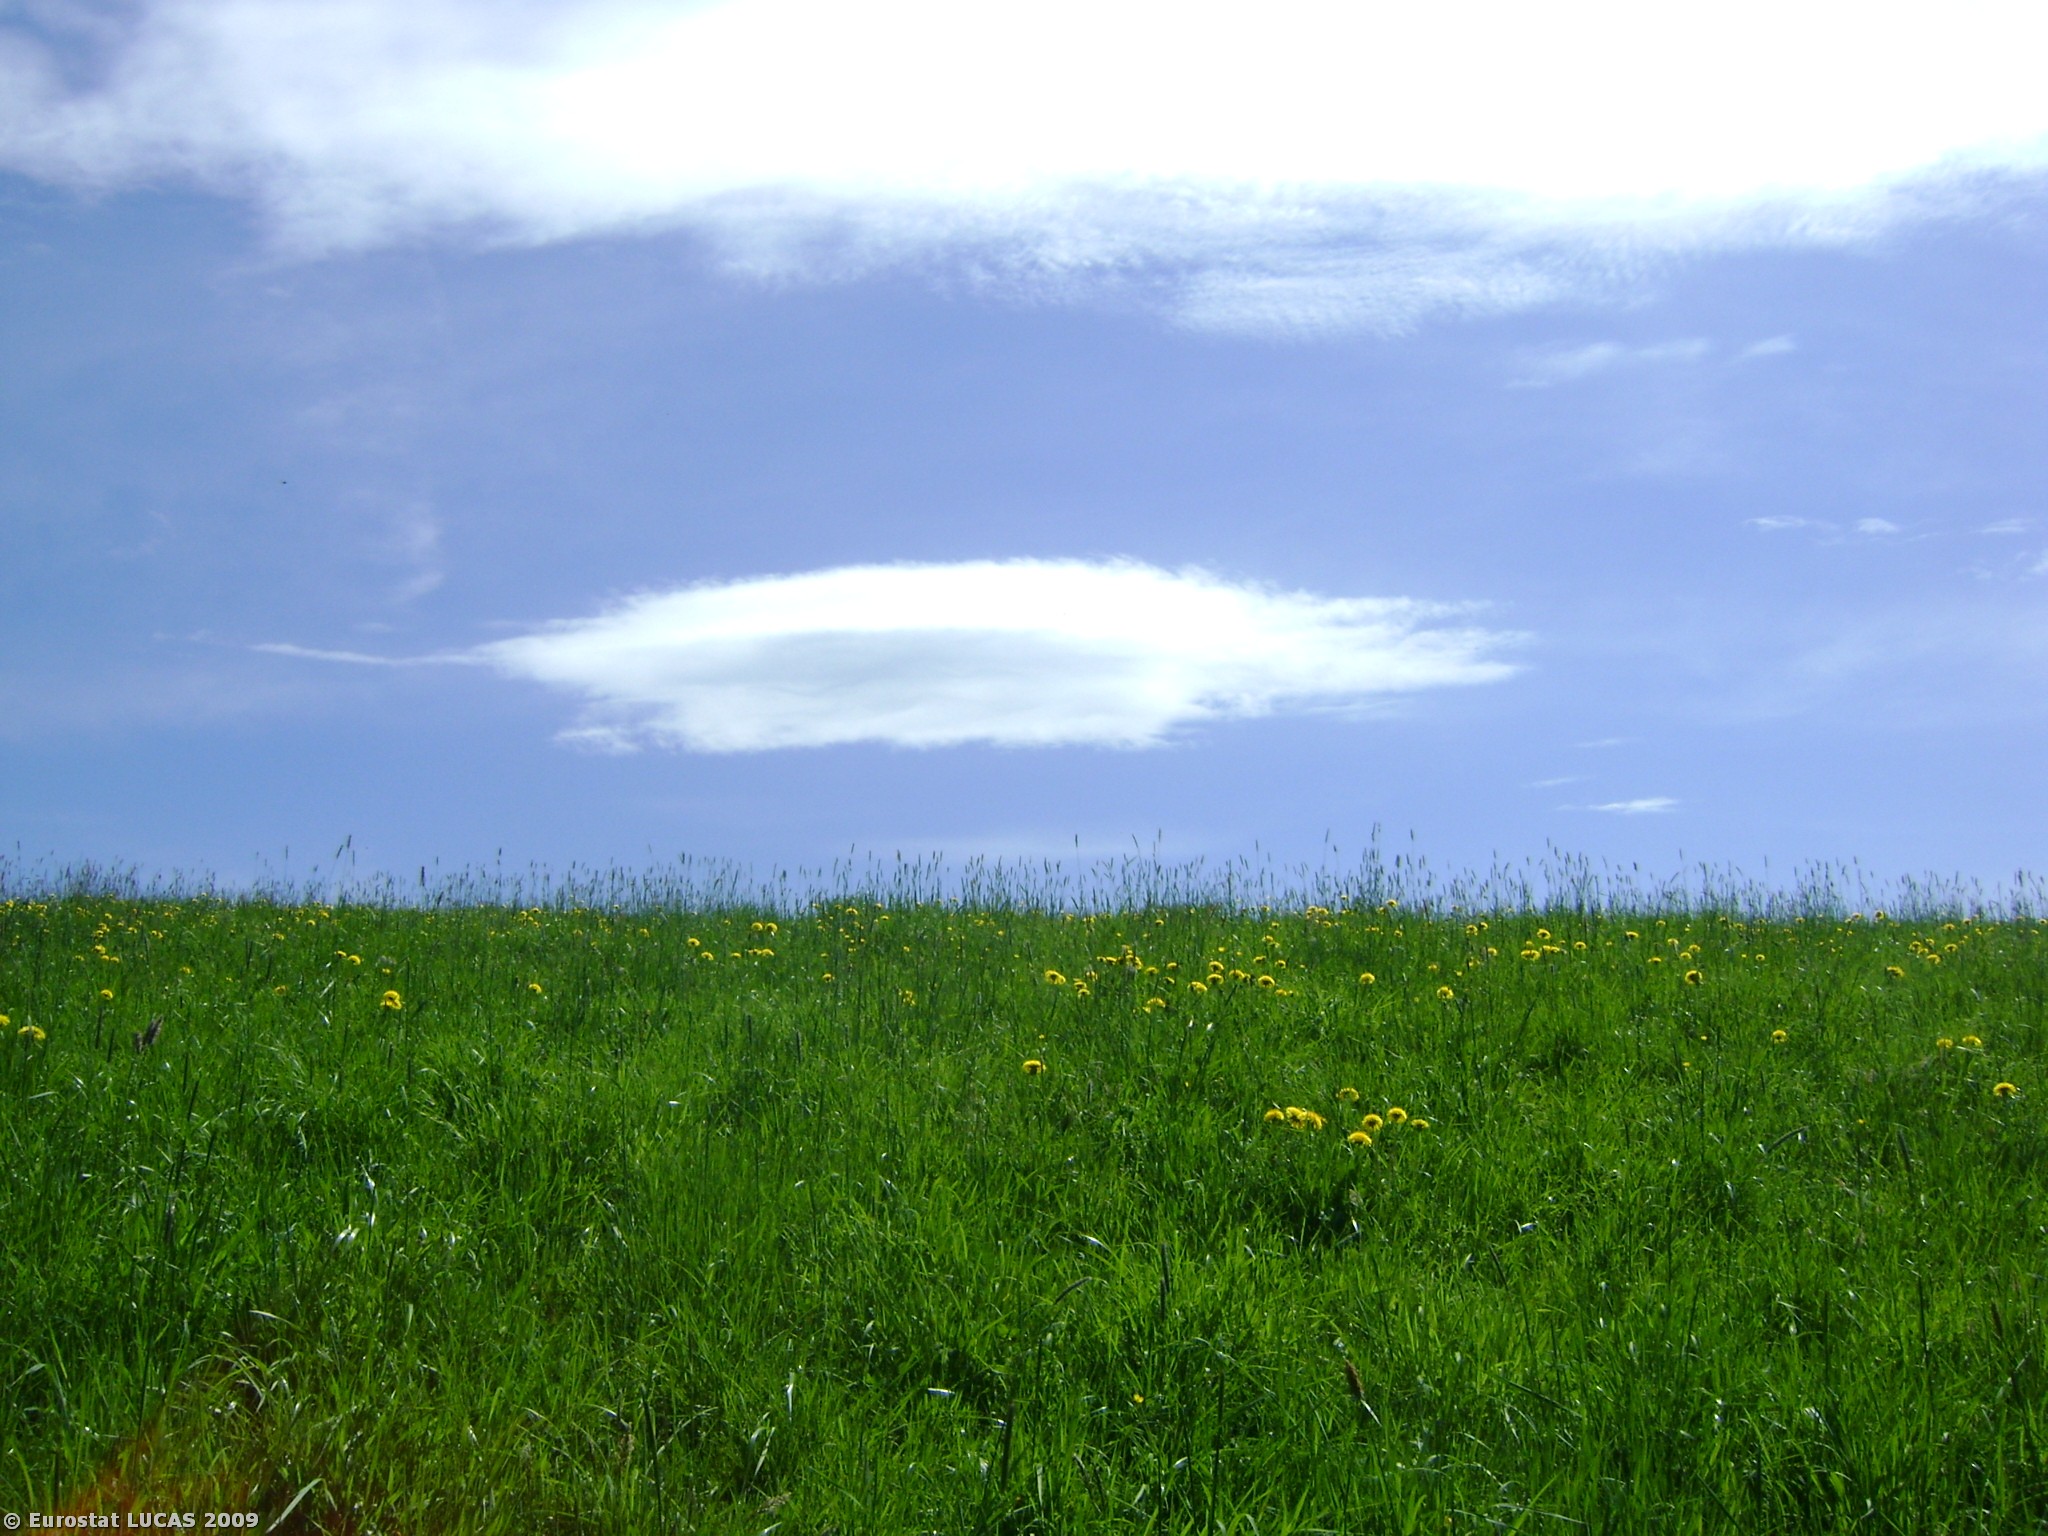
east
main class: Grassland
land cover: Grassland without tree/shrub cover
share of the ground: > 75 %
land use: Agriculture (excluding fallow land and kitchen gardens)
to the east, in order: Grassland without tree/shrub cover; Paved roads, cycling and walking lanes; Grassland without tree/shrub cover
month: May
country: AT
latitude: 47.9243
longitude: 13.2241
